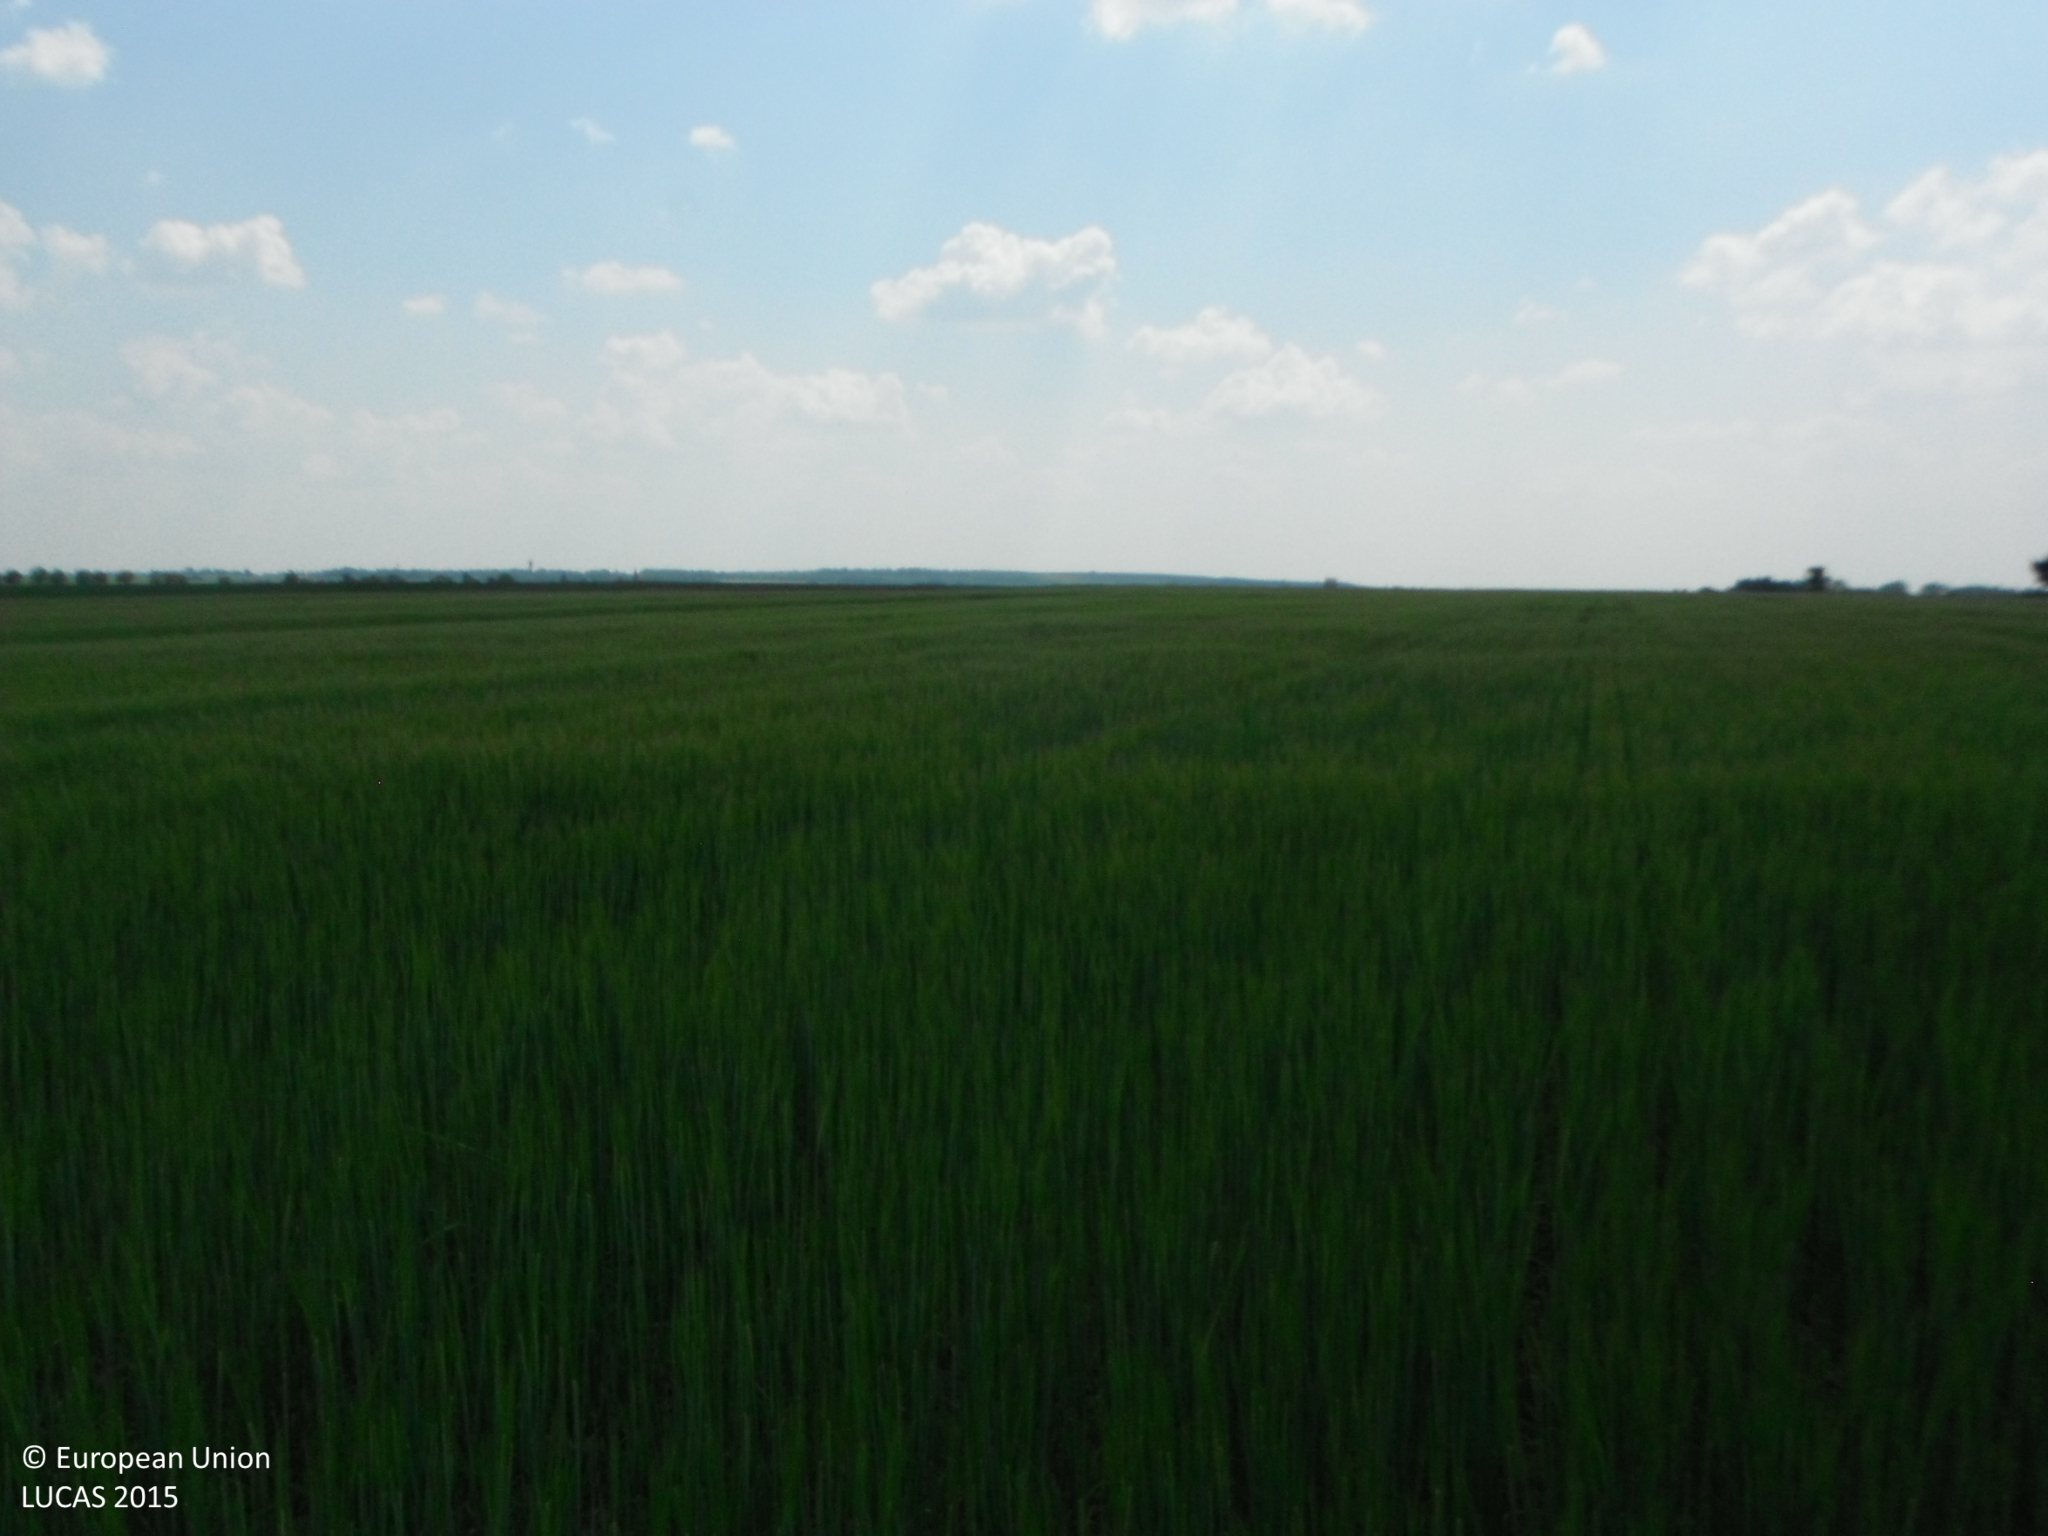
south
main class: Cropland
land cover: Barley
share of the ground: > 75 %
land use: Agriculture (excluding fallow land and kitchen gardens)
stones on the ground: < 10 %
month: June
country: SK
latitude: 48.4244
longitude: 17.4291
